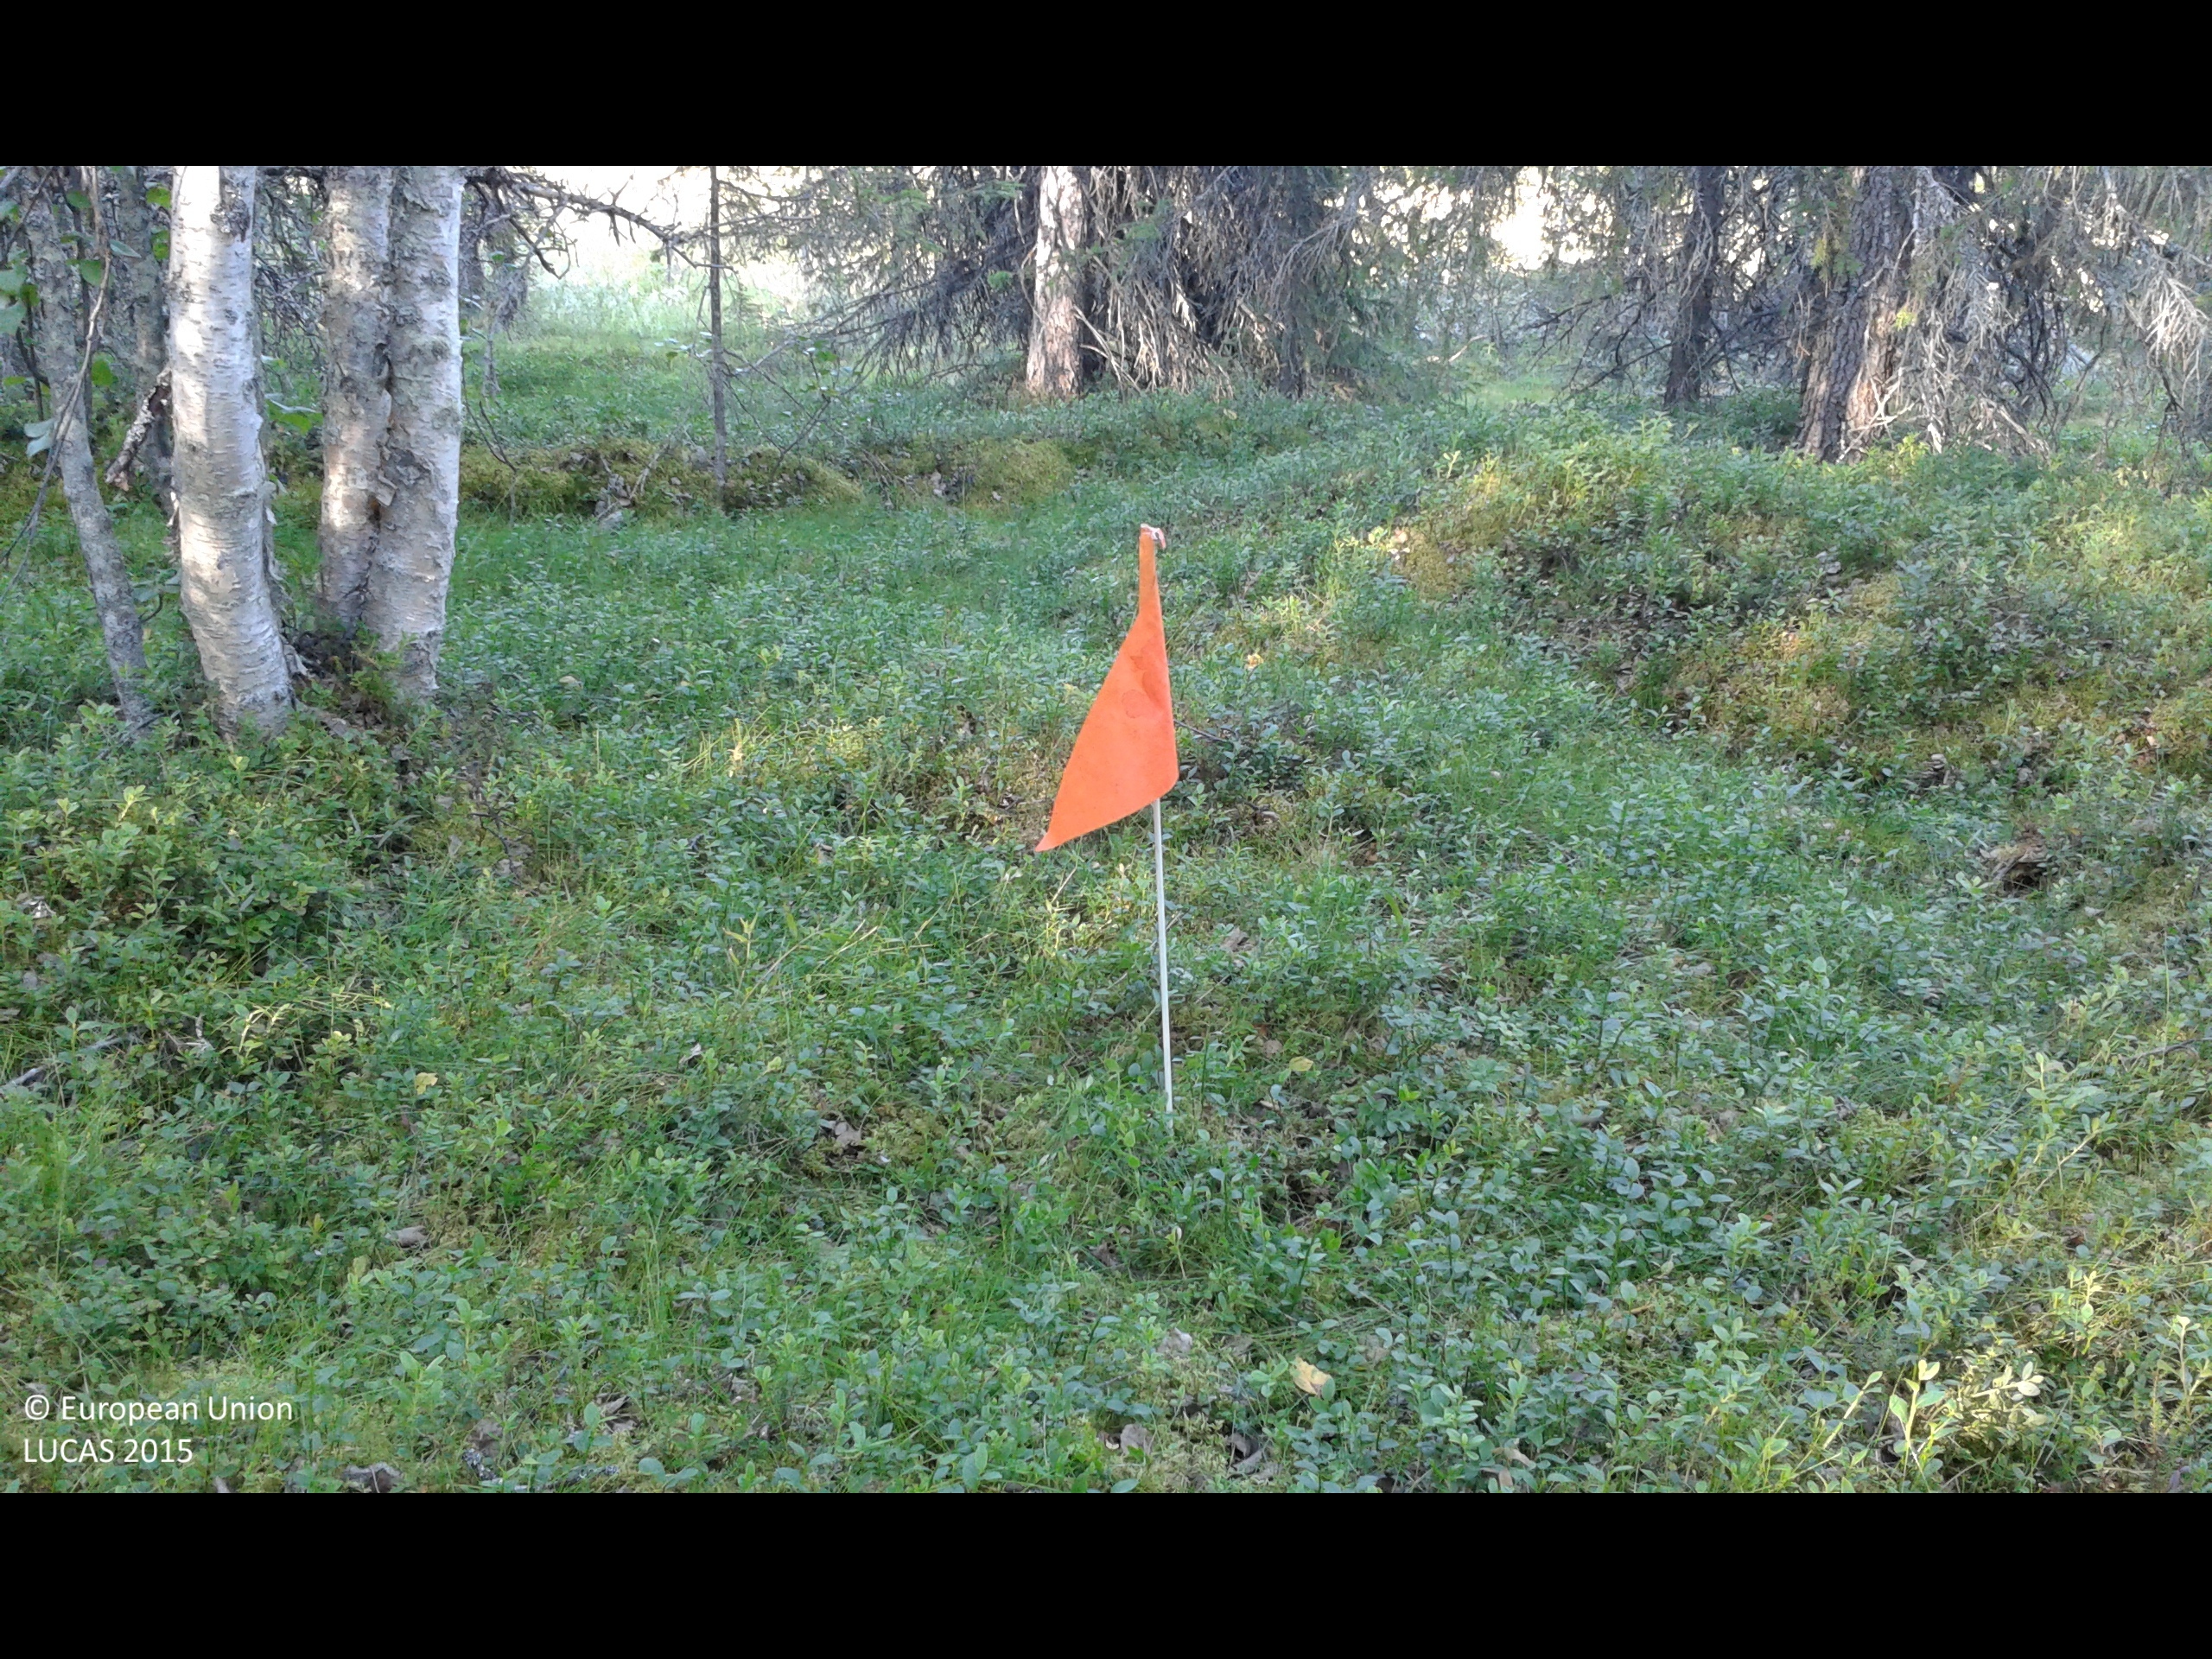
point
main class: Woodland
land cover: Spruce dominated mixed woodland
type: boreal forest
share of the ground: 25 - 50 %
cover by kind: shrubs 50 %, coniferous forest trees 25 %, lichens and mosses 15 %, broadleaved forest trees 10 %
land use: Forestry
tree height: > 5 m
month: August
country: SE
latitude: 67.3158
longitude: 21.1731
